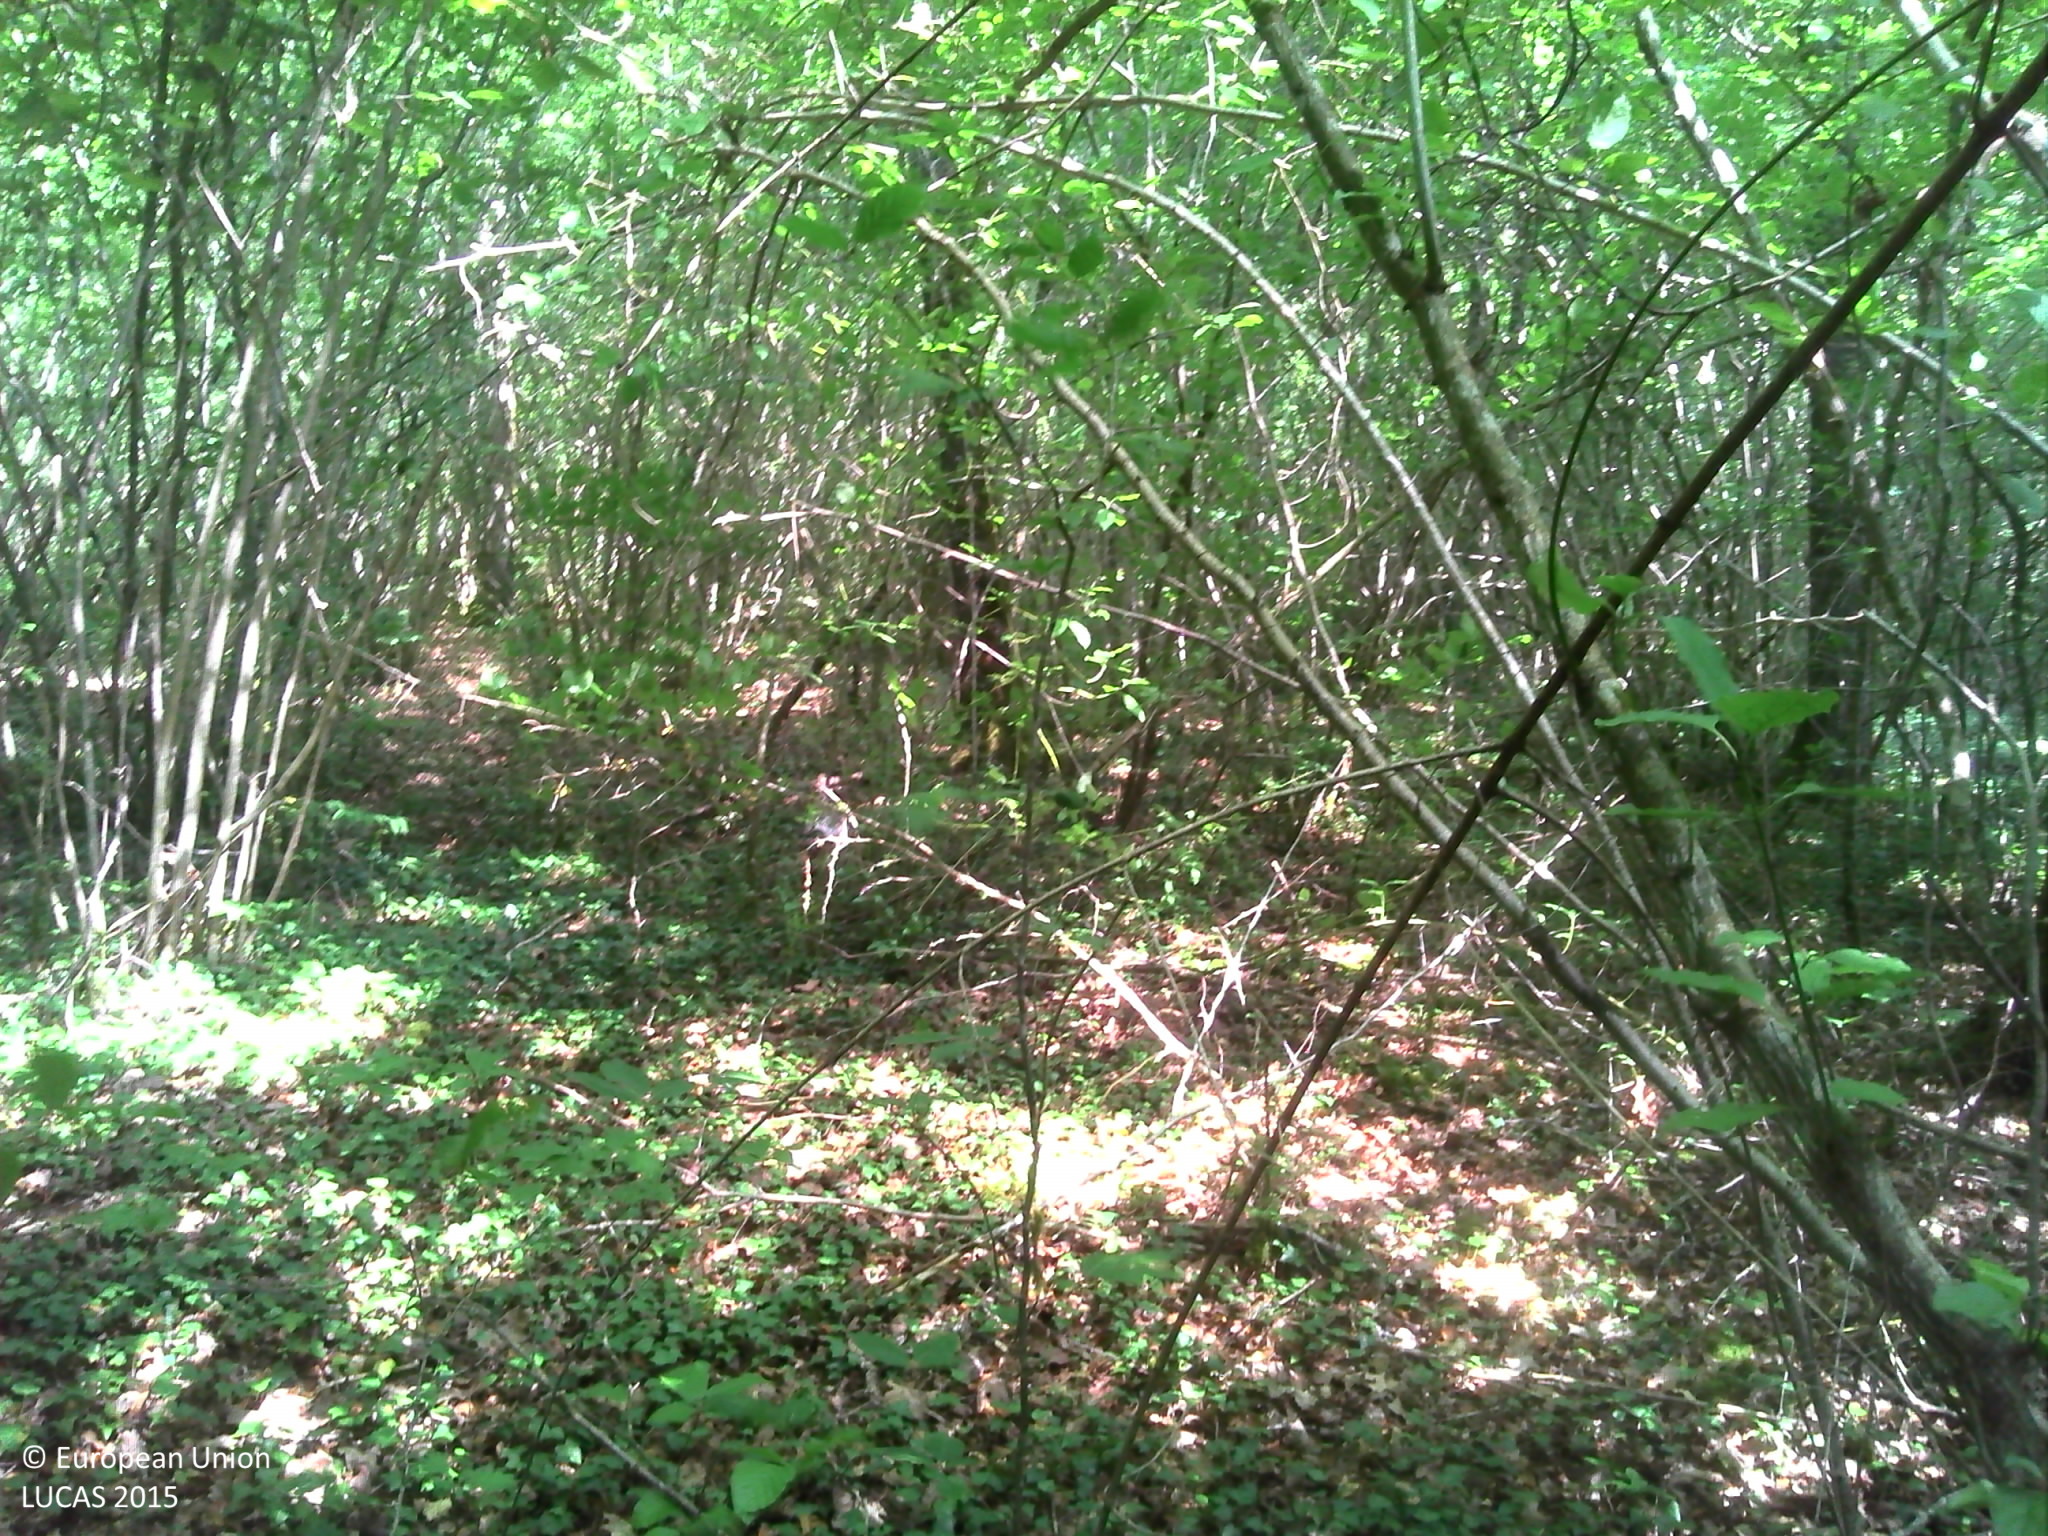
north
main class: Woodland
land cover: Broadleaved woodland
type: mesophytic deciduous forest
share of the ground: > 75 %
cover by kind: broadleaved forest trees 90 %, herbaceous plants 5 %, lichens and mosses 5 %
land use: Forestry
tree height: > 5 m
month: July
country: FR
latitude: 47.6385
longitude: 3.5673
